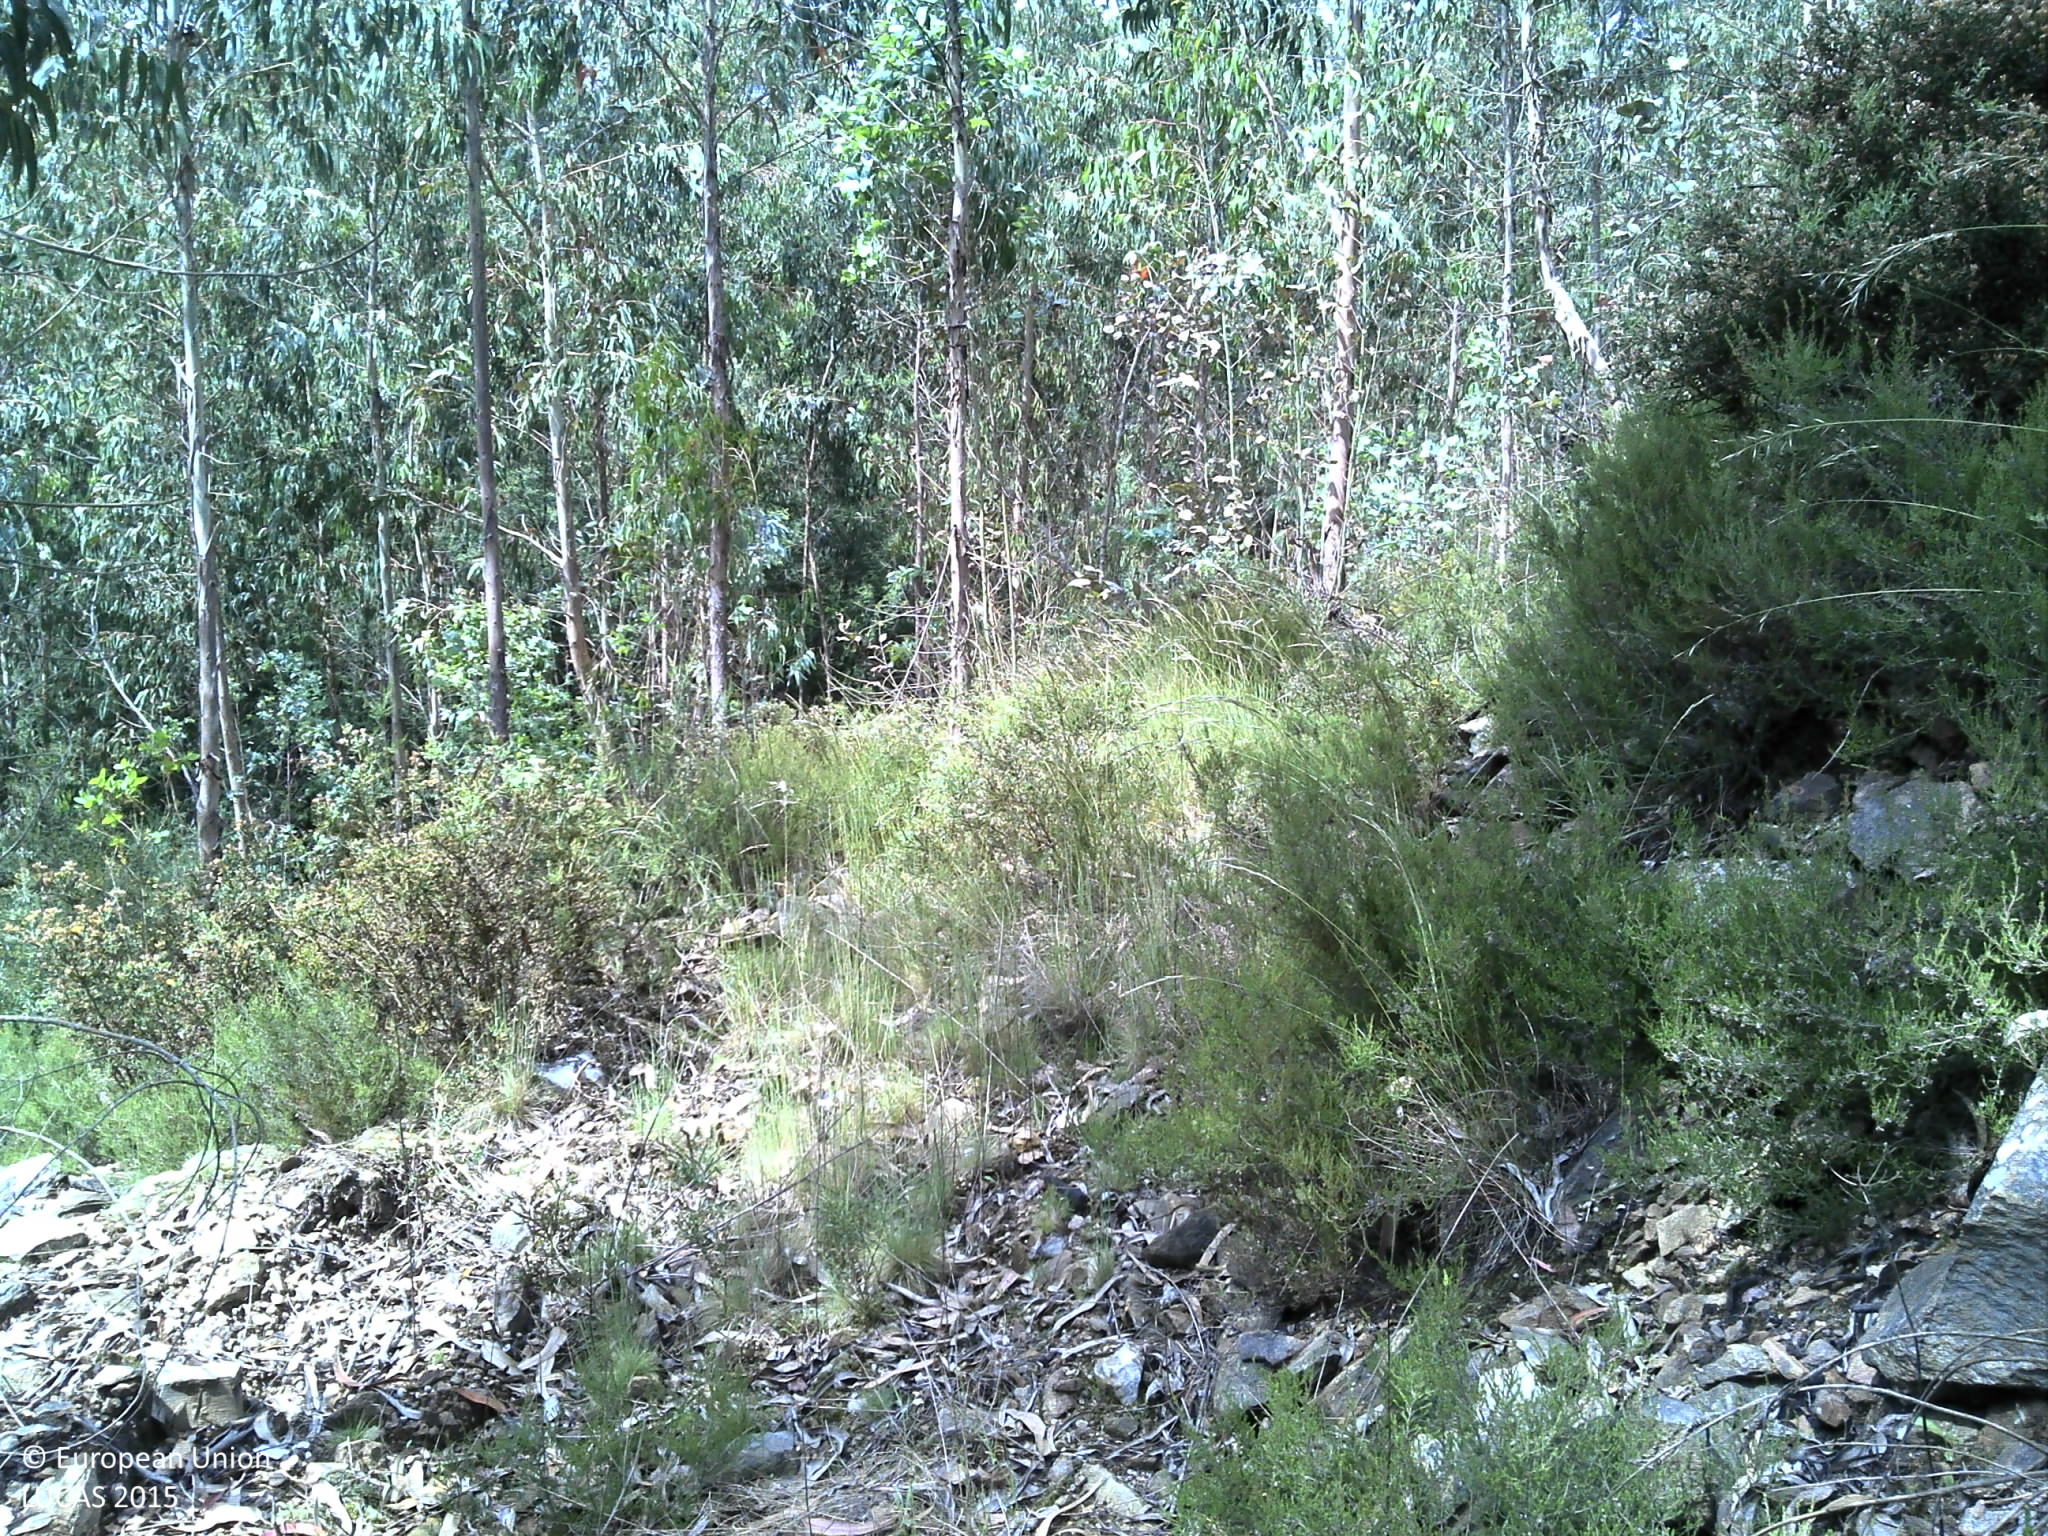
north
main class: Woodland
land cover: Broadleaved woodland
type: exotic forest
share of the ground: 50 - 75 %
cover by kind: broadleaved forest trees 70 %, shrubs 25 %, unconsolidated bare surface 5 %
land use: Forestry
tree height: > 5 m
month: May
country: PT
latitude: 41.2565
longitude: -8.4457
